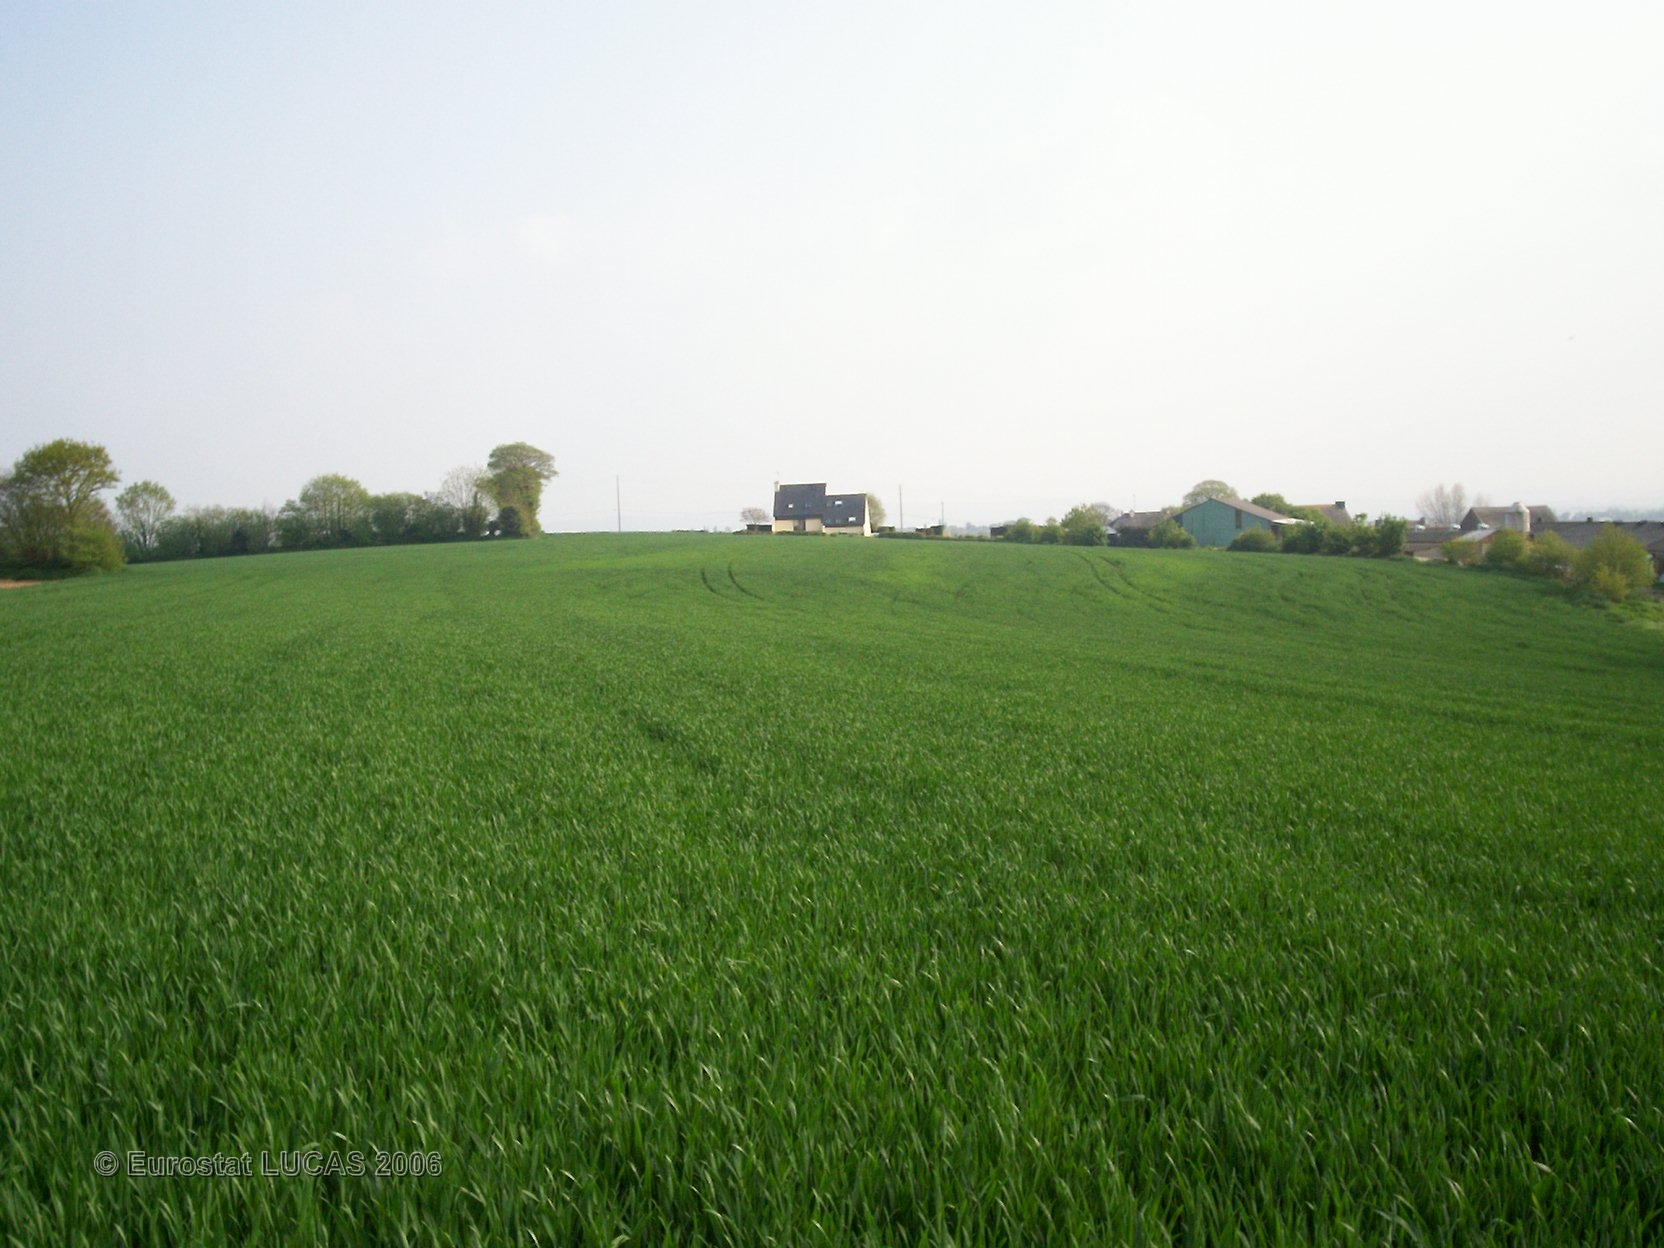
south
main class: Cropland
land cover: Common wheat
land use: Agriculture (excluding fallow land and kitchen gardens)
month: May
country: FR
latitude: 48.2415
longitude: -3.9697
